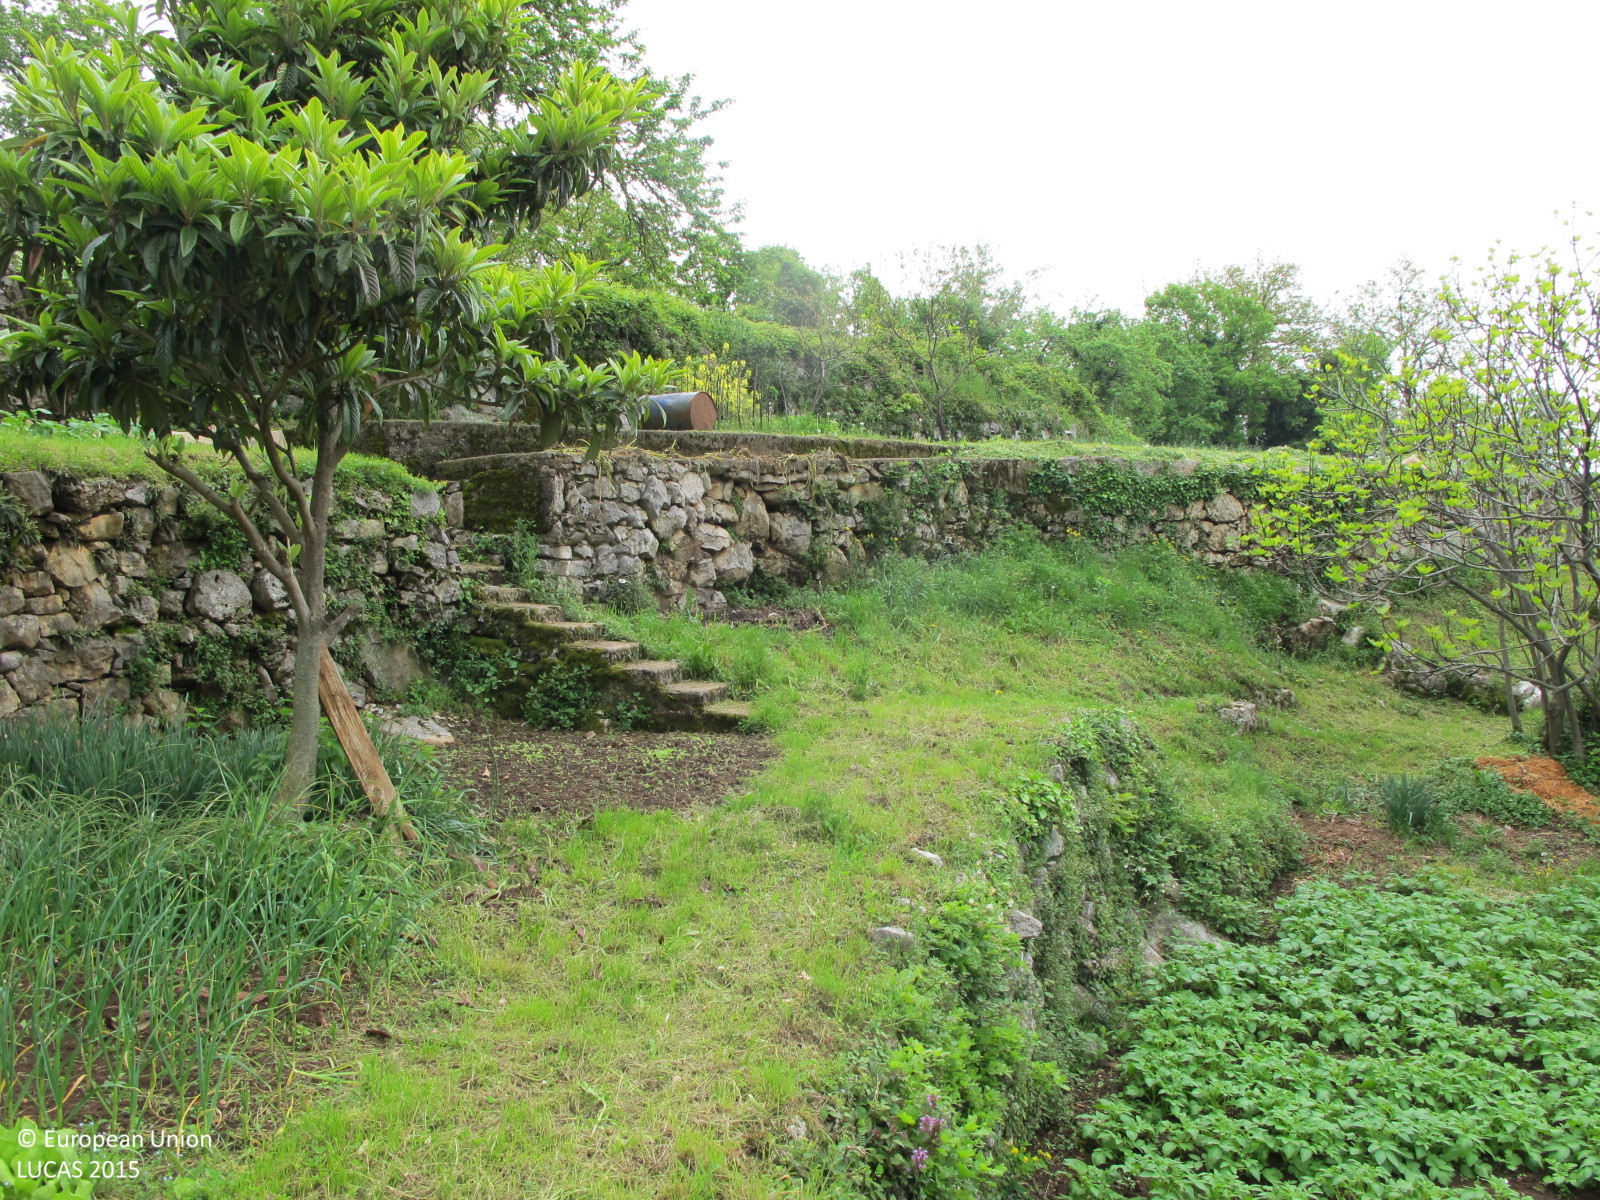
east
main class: Cropland
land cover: Other fresh vegetables
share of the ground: > 75 %
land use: Kitchen garden
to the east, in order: Other fresh vegetables; Shrubland without tree cover; Paved roads, cycling and walking lanes; Broadleaved woodland; Electric lines; Broadleaved woodland; Tracks; Broadleaved woodland
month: May
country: HR
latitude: 45.3279
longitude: 14.2691
